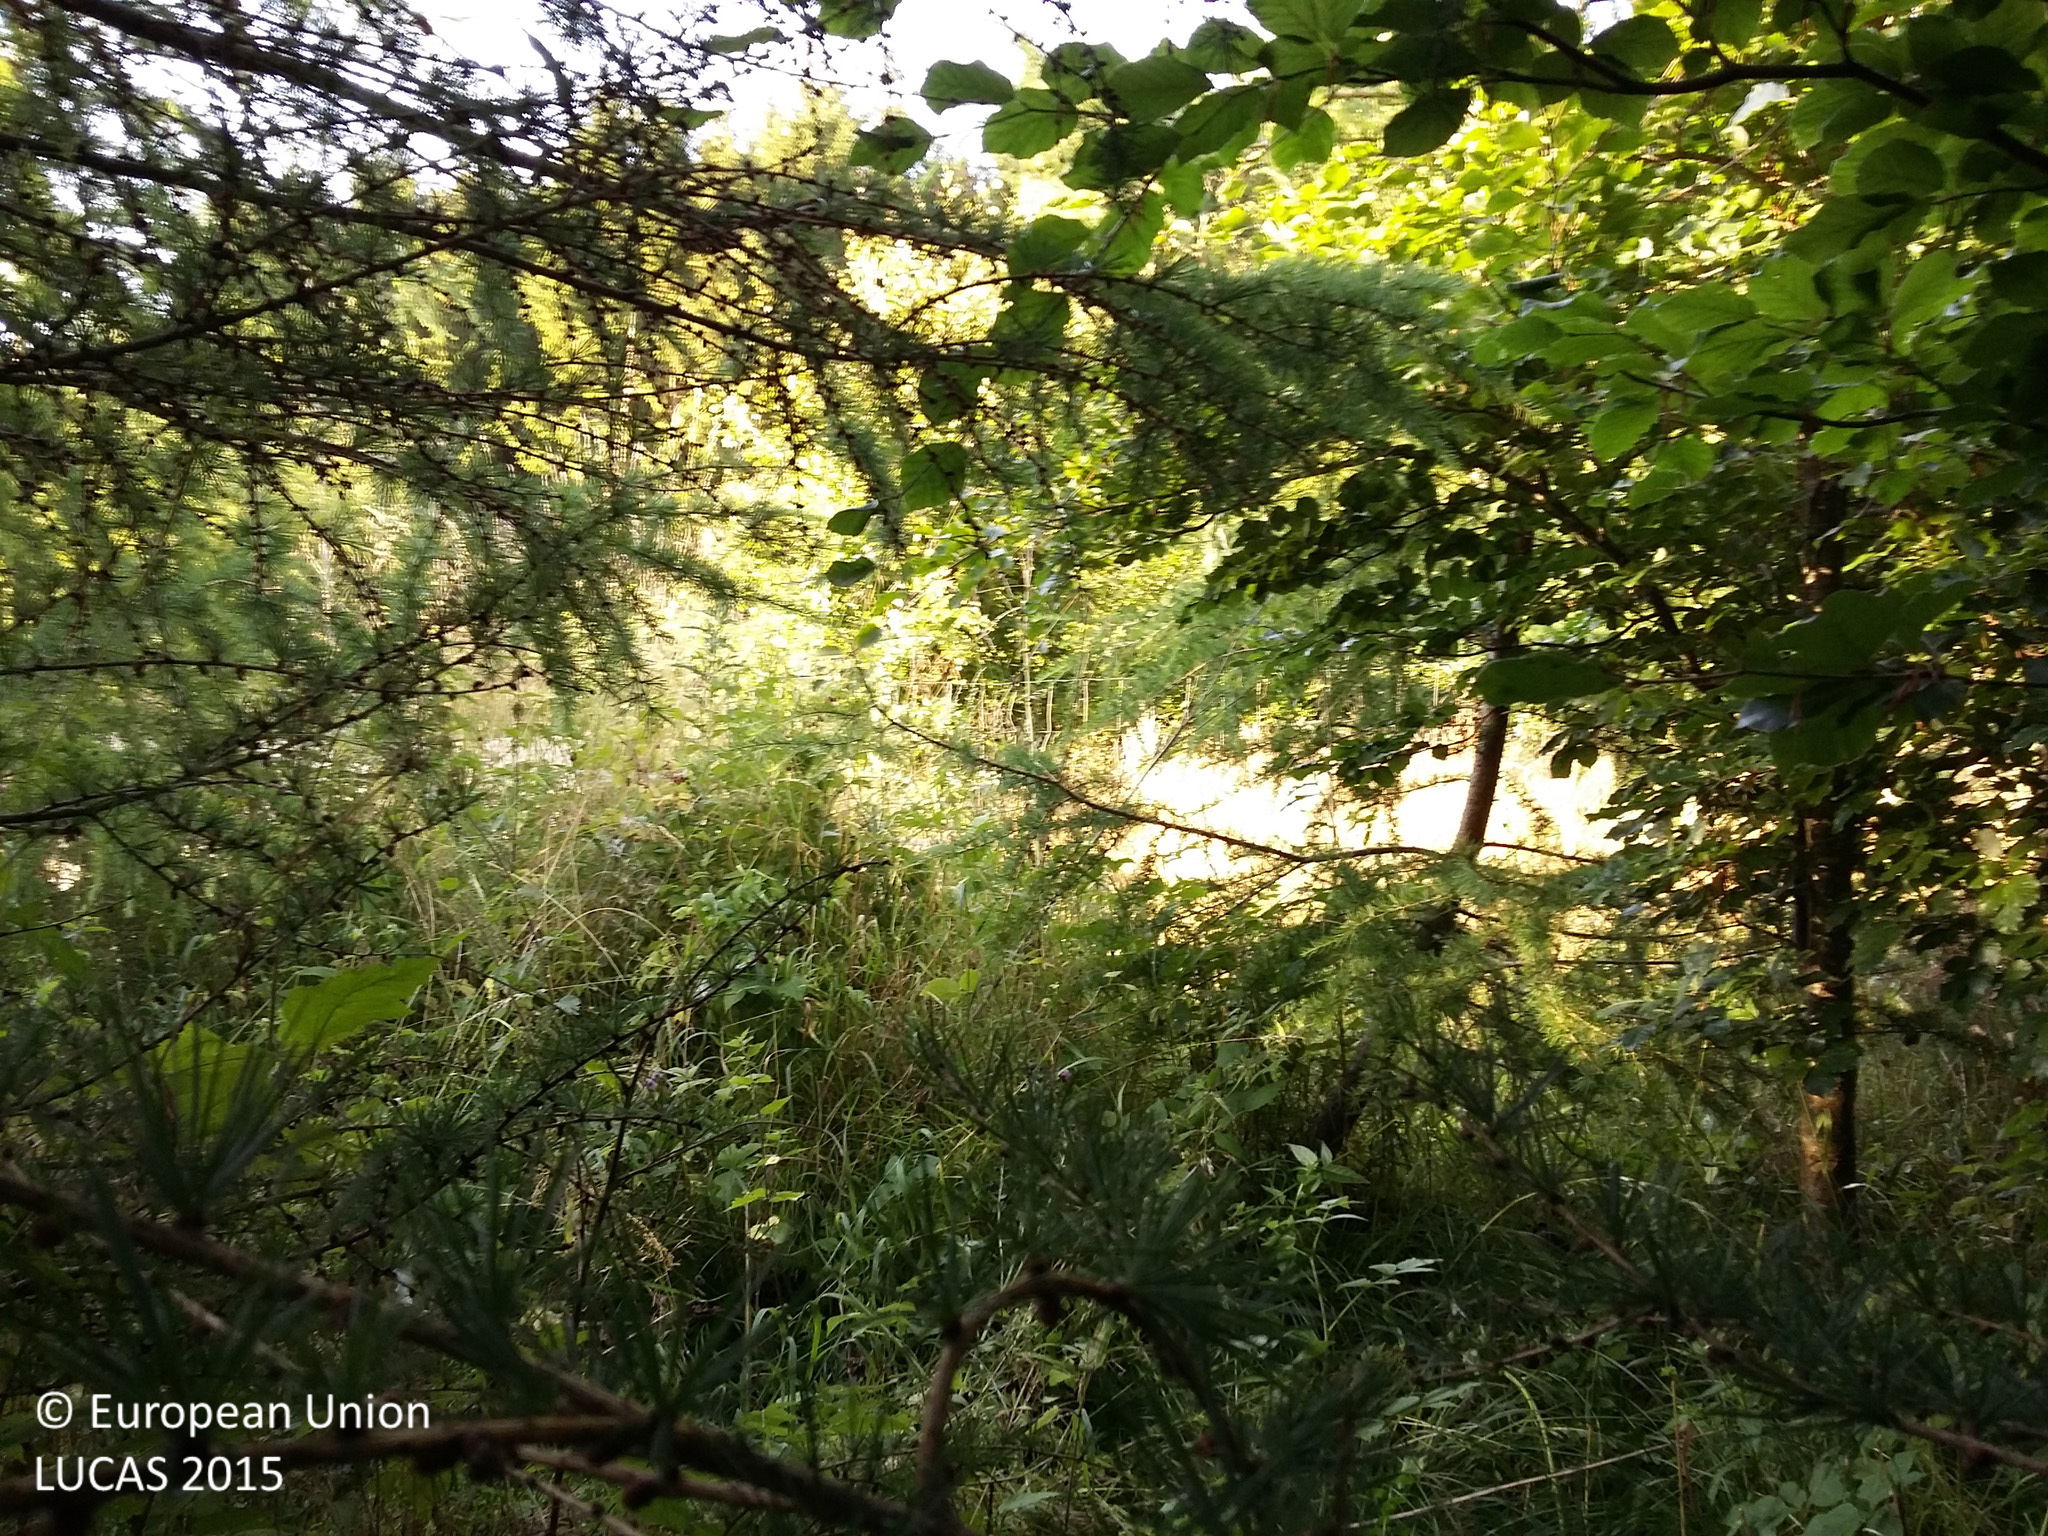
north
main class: Woodland
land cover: Other mixed woodland
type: beech forest
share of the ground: > 75 %
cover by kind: coniferous forest trees 50 %, broadleaved forest trees 40 %, shrubs 5 %, herbaceous plants 5 %
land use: Forestry
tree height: > 5 m
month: August
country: DK
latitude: 55.3625
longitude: 12.0335
